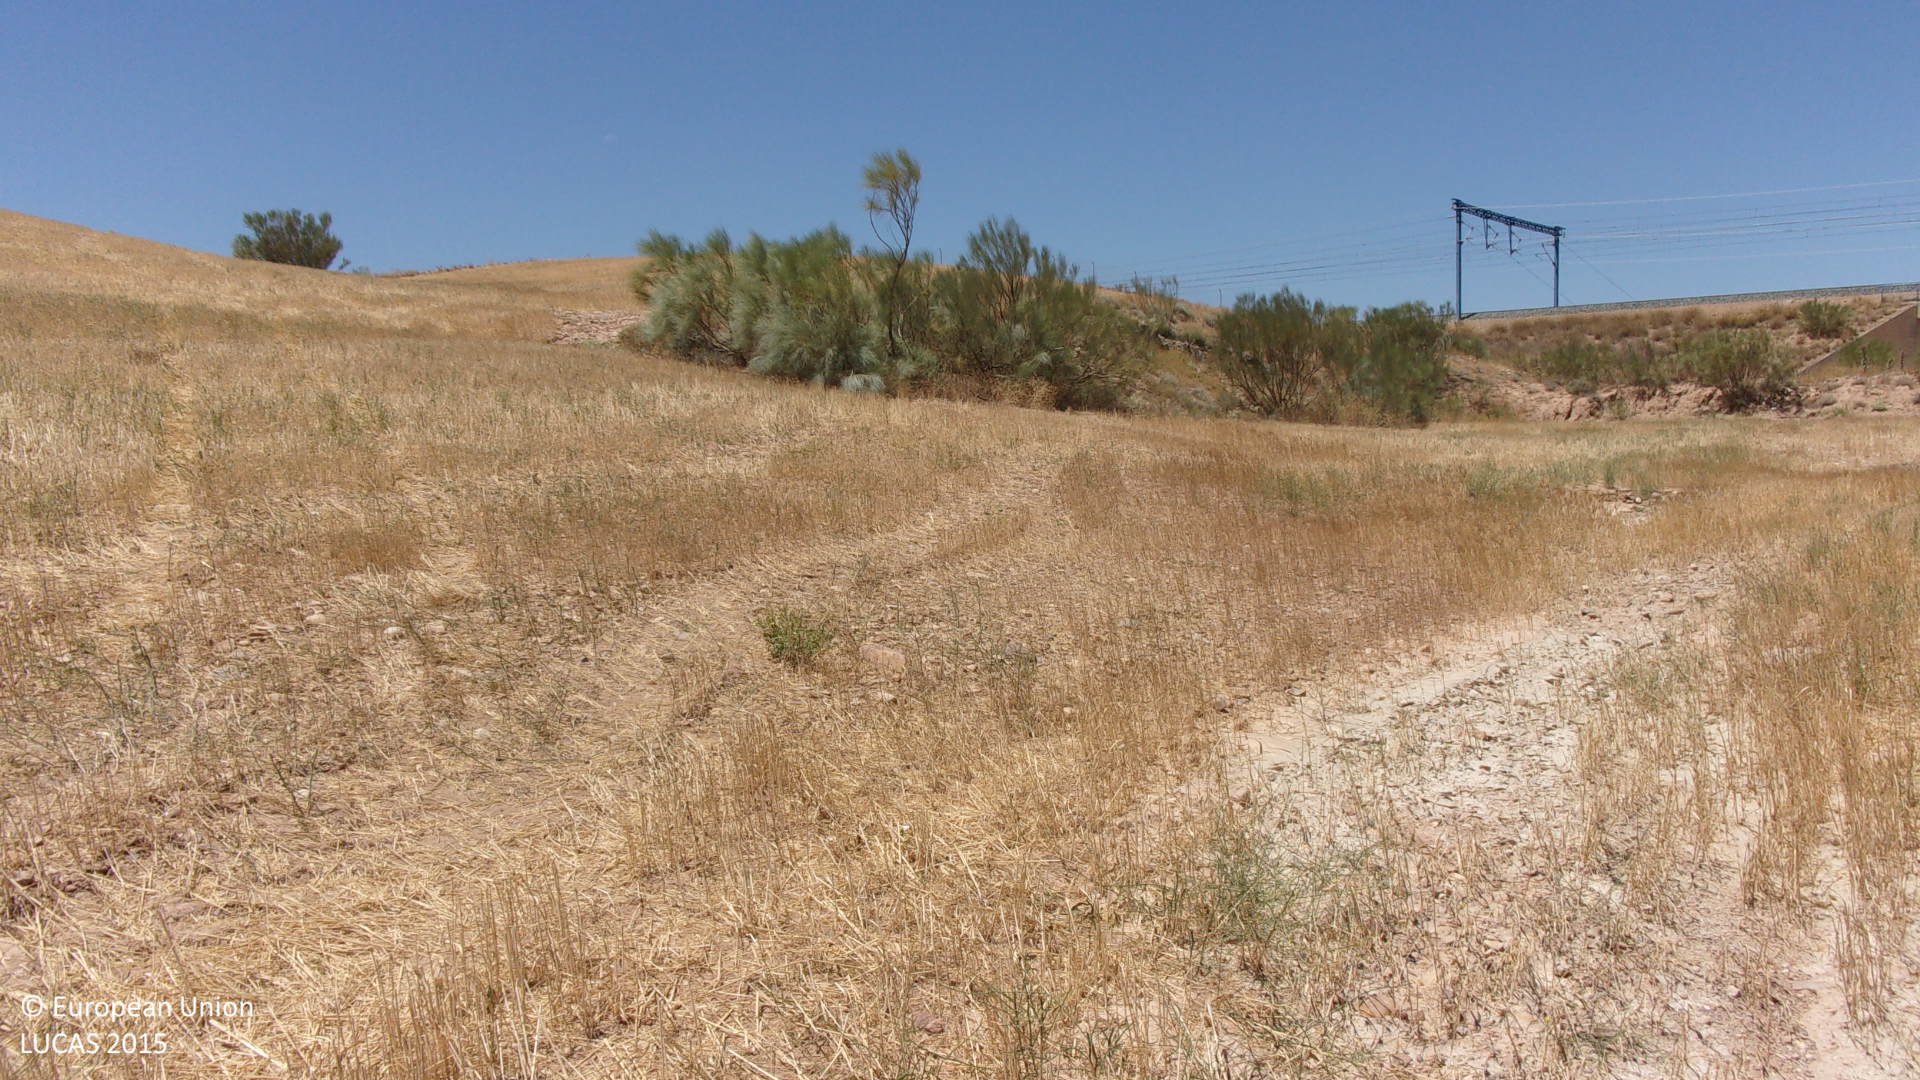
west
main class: Cropland
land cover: Durum wheat
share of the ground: < 10 %
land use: Agriculture (excluding fallow land and kitchen gardens)
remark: Harvested field
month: July
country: ES
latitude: 41.6783
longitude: -1.2567
